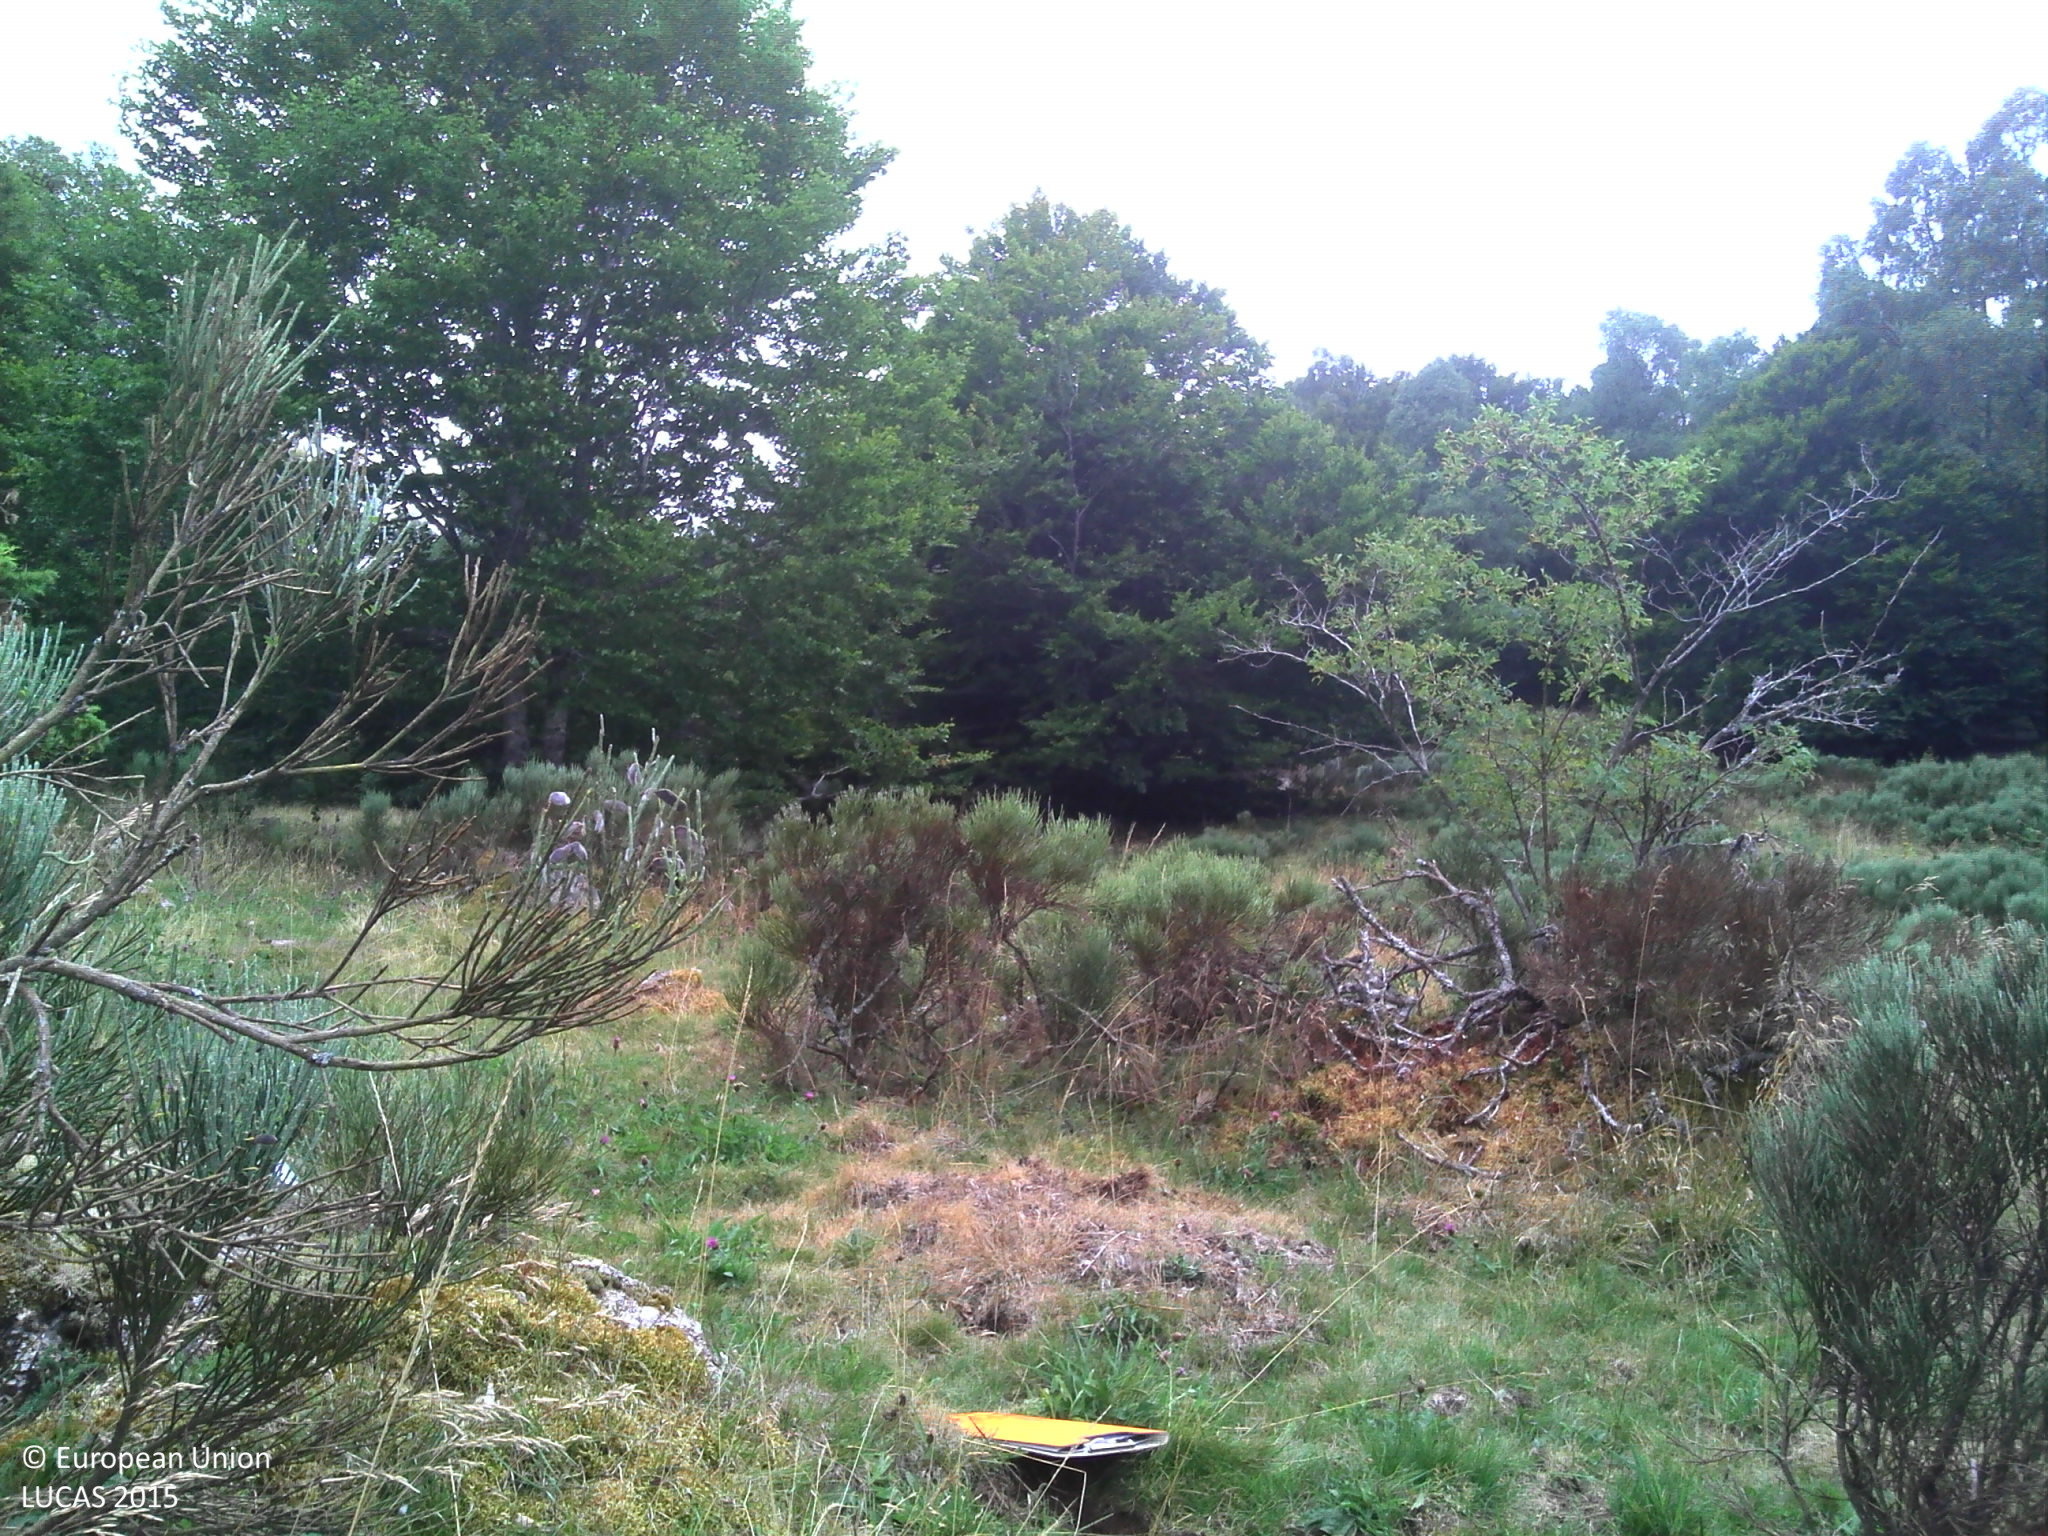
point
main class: Shrubland
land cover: Shrubland with sparse tree cover
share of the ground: > 75 %
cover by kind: shrubs 60 %, herbaceous plants 35 %, coniferous forest trees 5 %
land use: Agriculture (excluding fallow land and kitchen gardens)
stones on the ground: 25 - 50 %
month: July
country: FR
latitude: 44.6538
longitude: 3.5105
